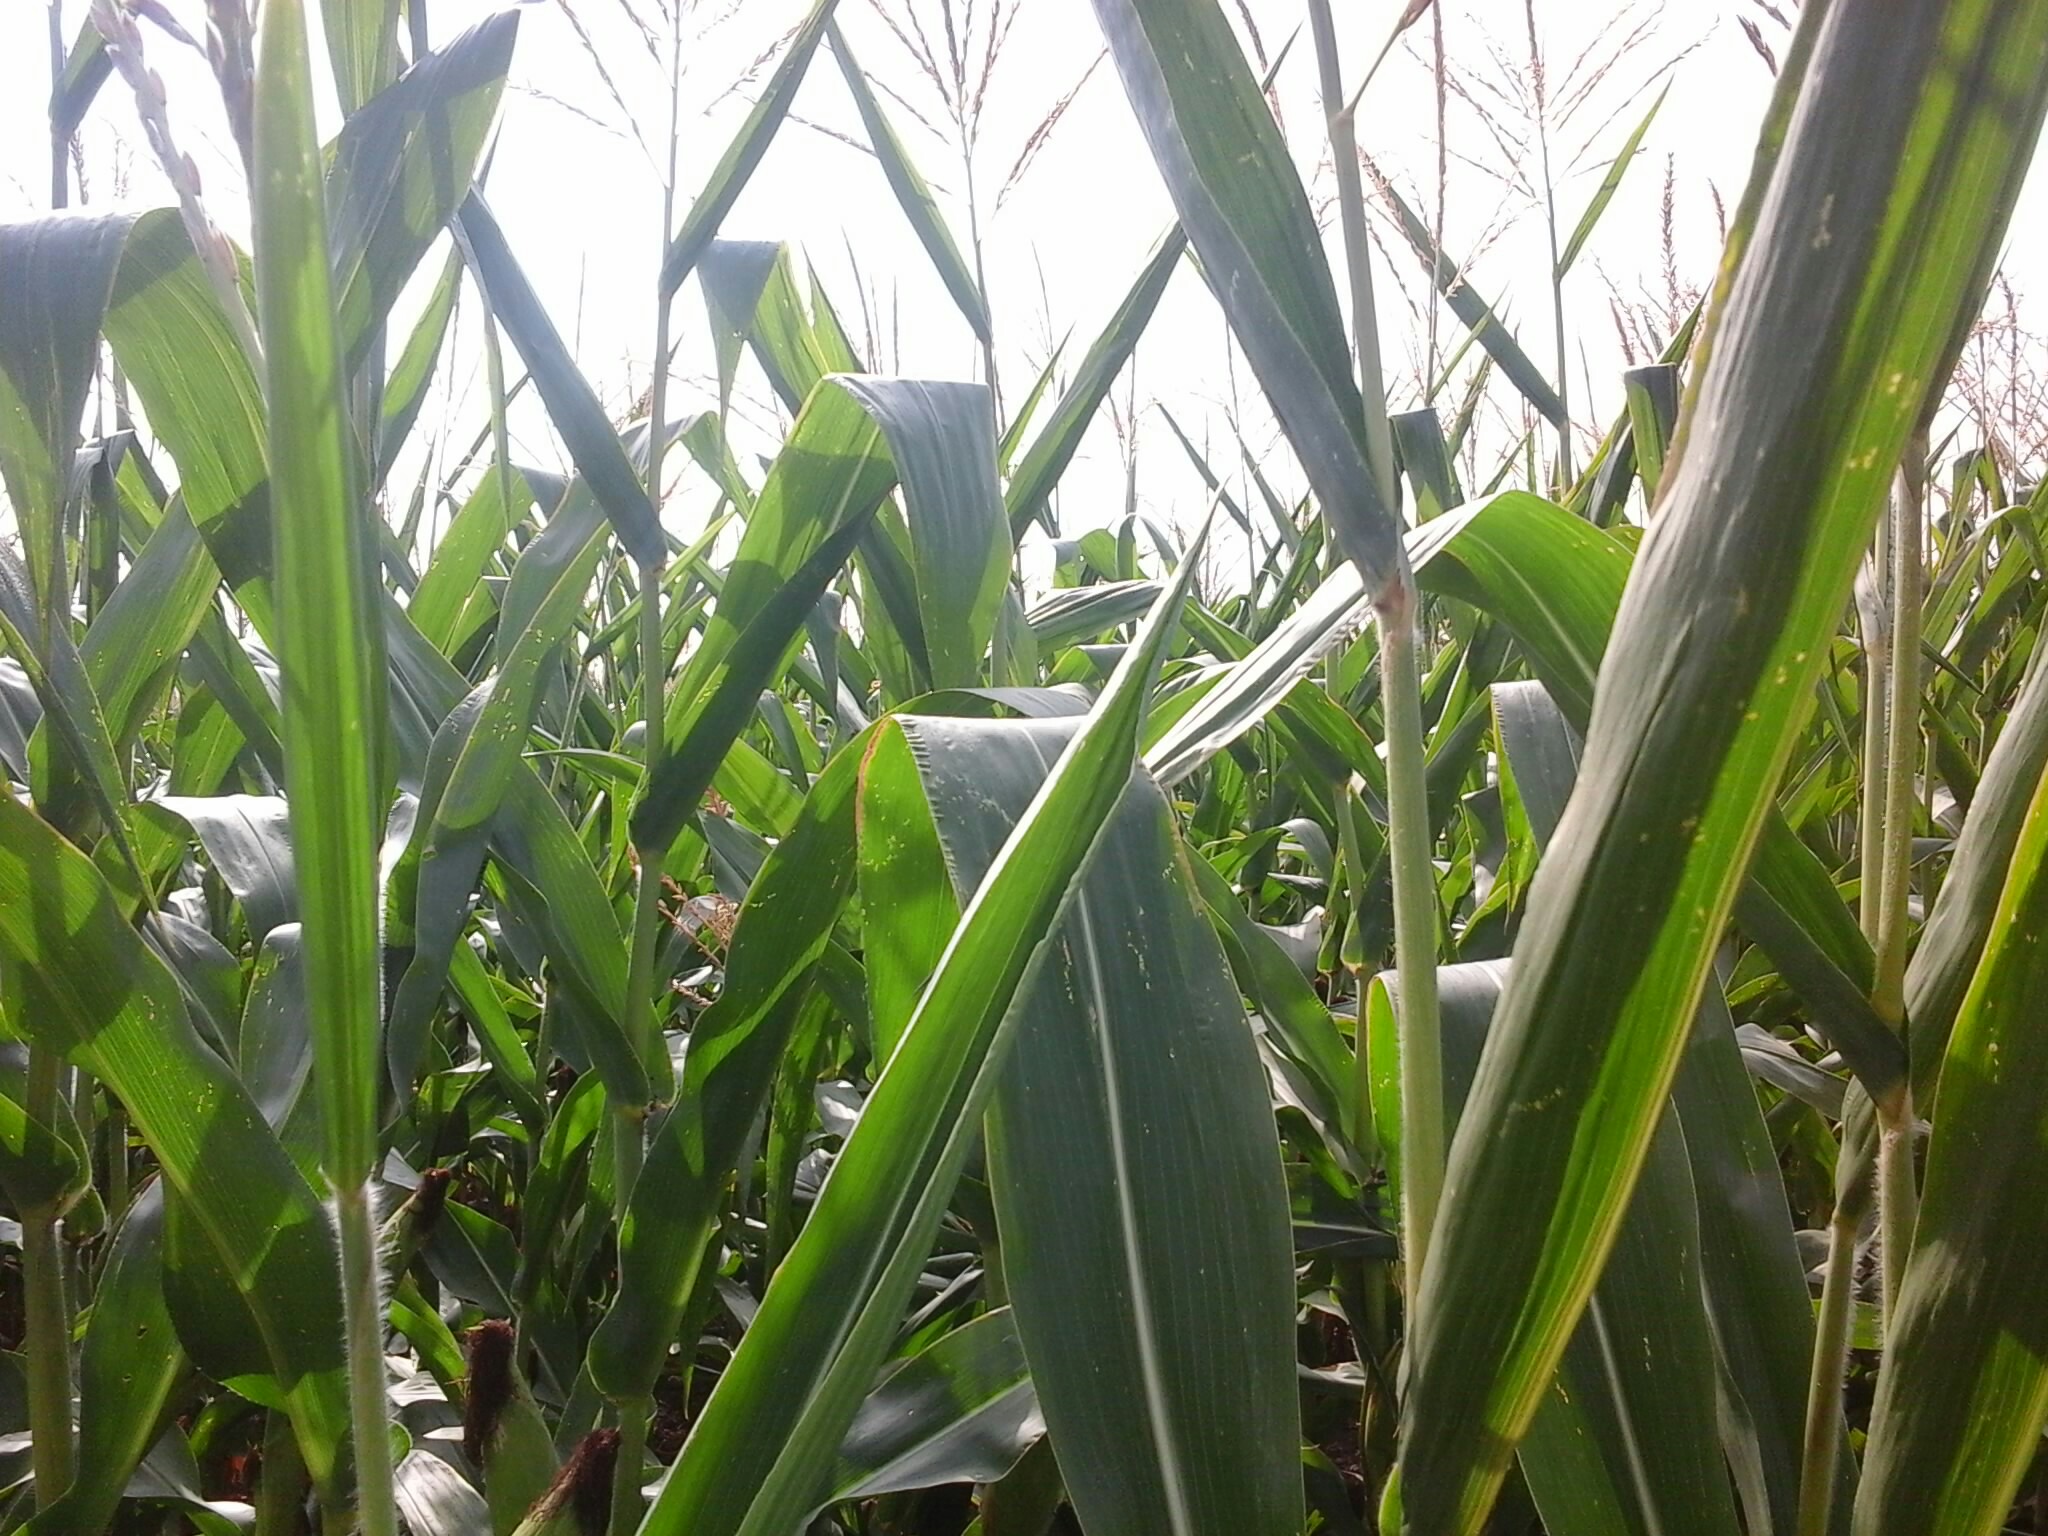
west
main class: Cropland
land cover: Maize
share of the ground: > 75 %
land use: Agriculture (excluding fallow land and kitchen gardens)
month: August
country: HU
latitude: 47.5372
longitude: 18.2087
